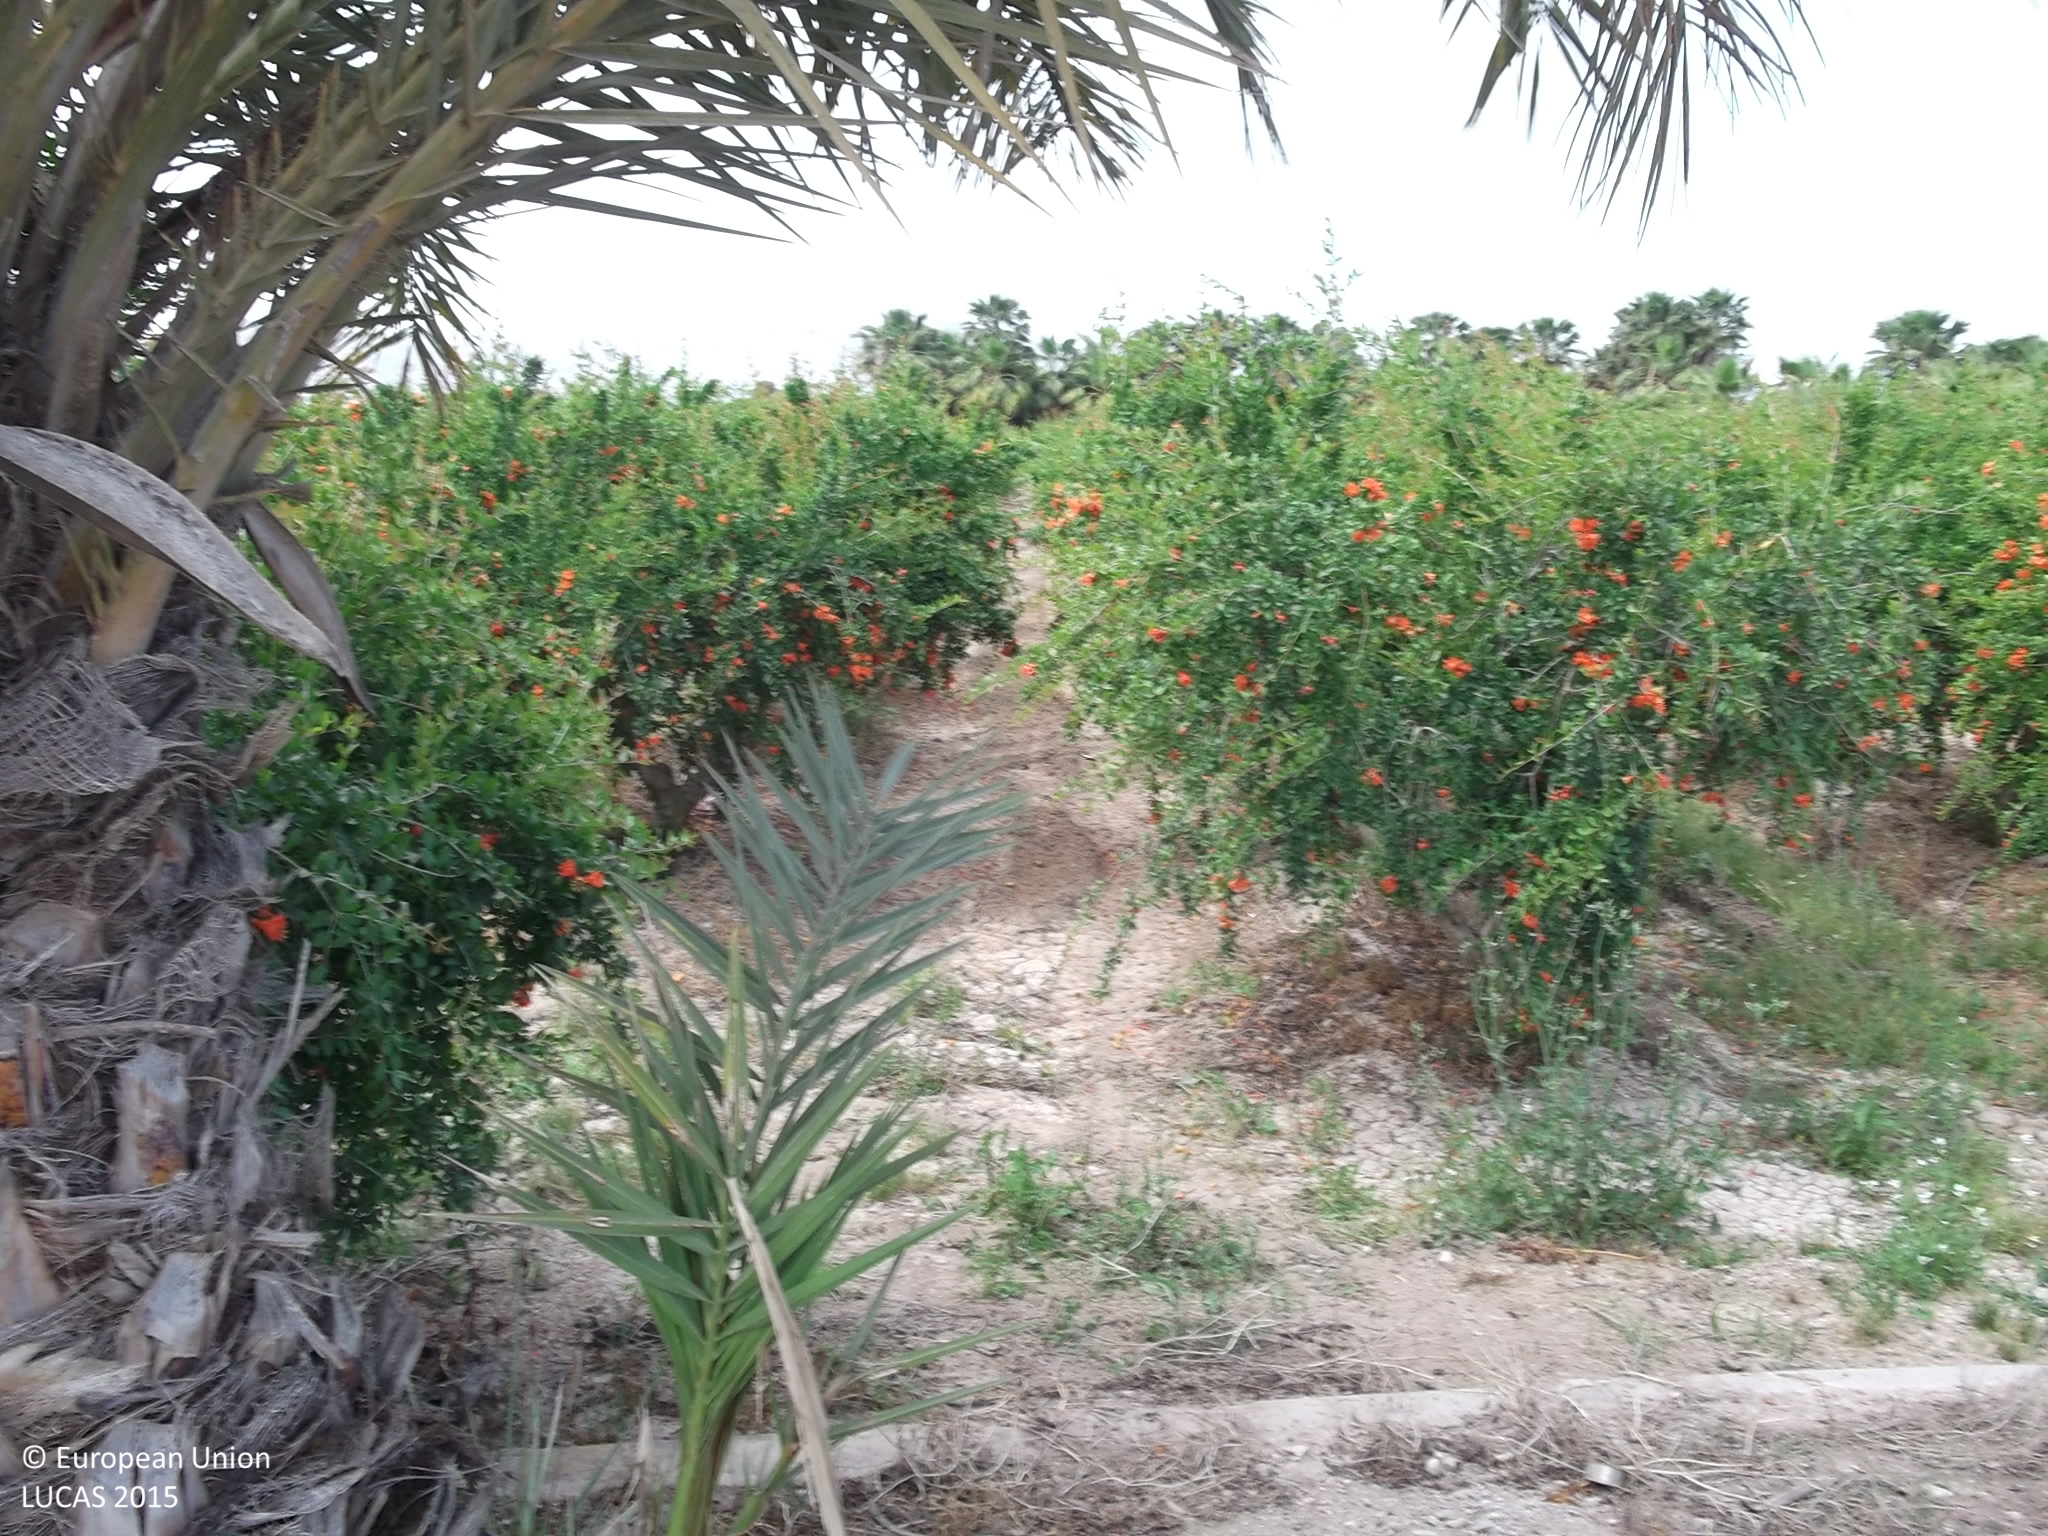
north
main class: Cropland
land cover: Other fruit trees and berries
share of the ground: 25 - 50 %
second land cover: Spontaneously vegetated surfaces
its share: > 75 %
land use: Agriculture (excluding fallow land and kitchen gardens)
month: May
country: ES
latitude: 38.1320
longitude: -0.8338
